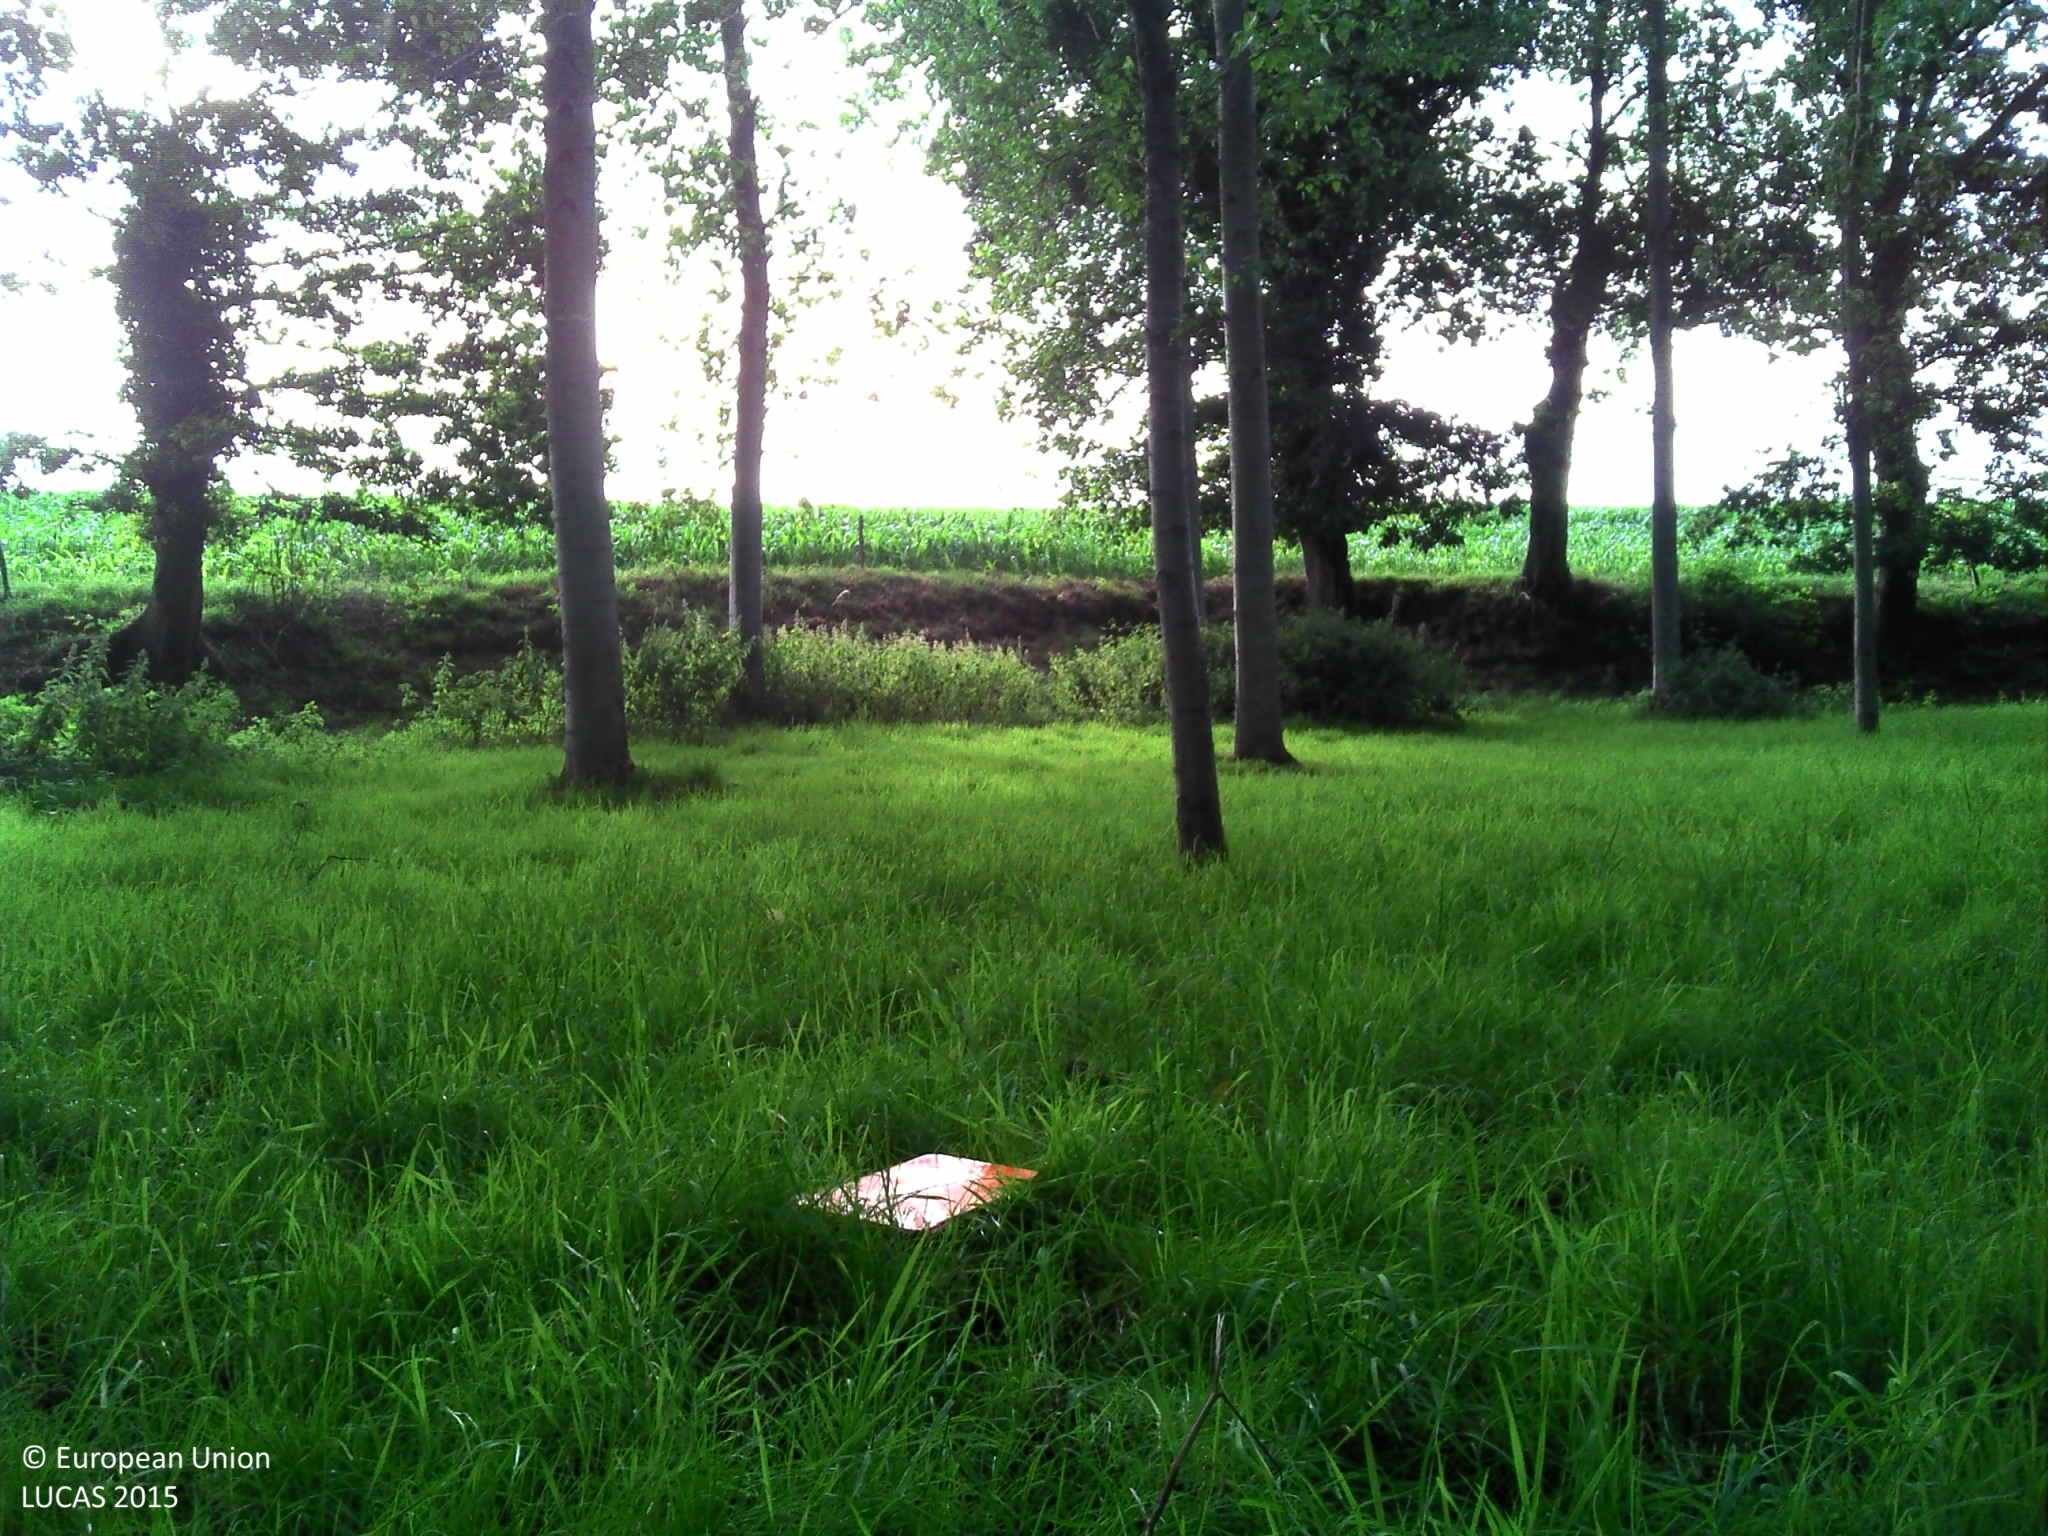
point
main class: Woodland
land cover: Broadleaved woodland
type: exotic forest
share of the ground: > 75 %
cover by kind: herbaceous plants 70 %, broadleaved forest trees 20 %, unconsolidated bare surface 10 %
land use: Forestry
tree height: > 5 m
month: July
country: FR
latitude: 48.4214
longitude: -2.4794
